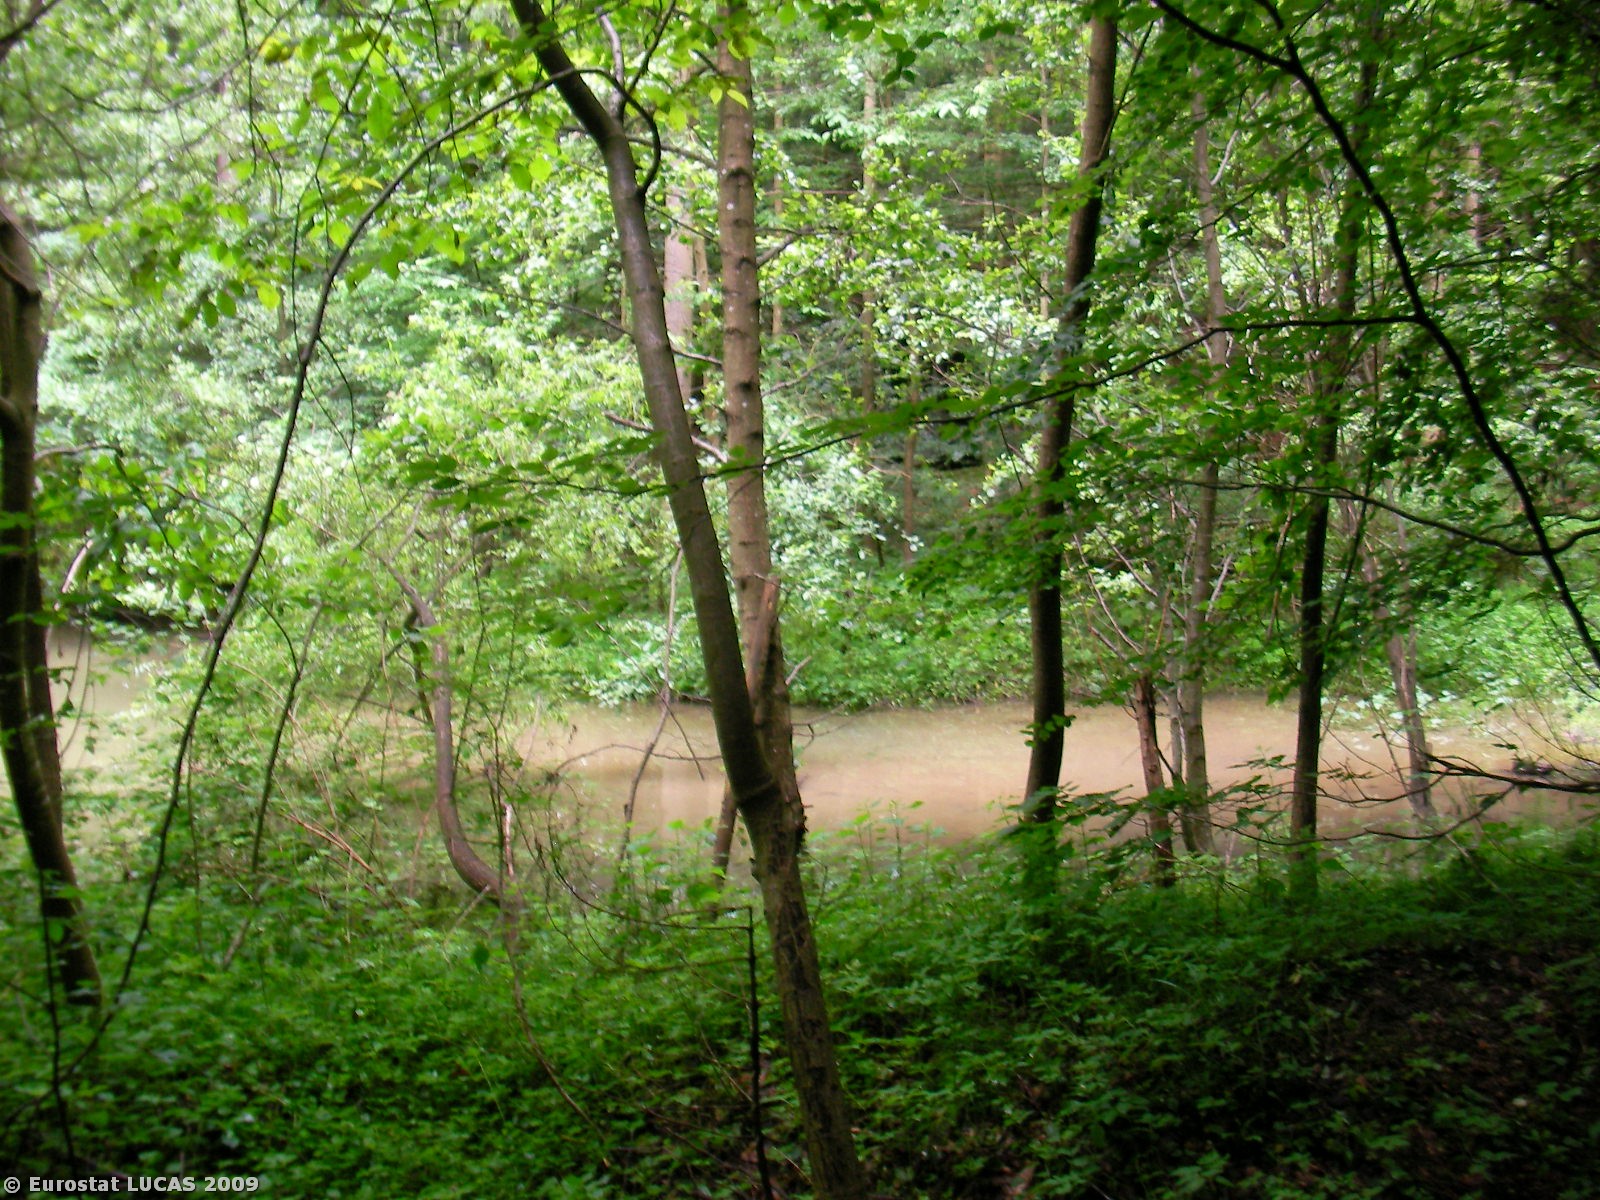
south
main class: Woodland
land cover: Mixed woodland
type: hemiboreal forest and nemoral coniferous forest and mixed broadleaved-coniferous forest
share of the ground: > 75 %
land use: Forestry
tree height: > 5 m
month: June
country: AT
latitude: 47.1360
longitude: 15.7360
